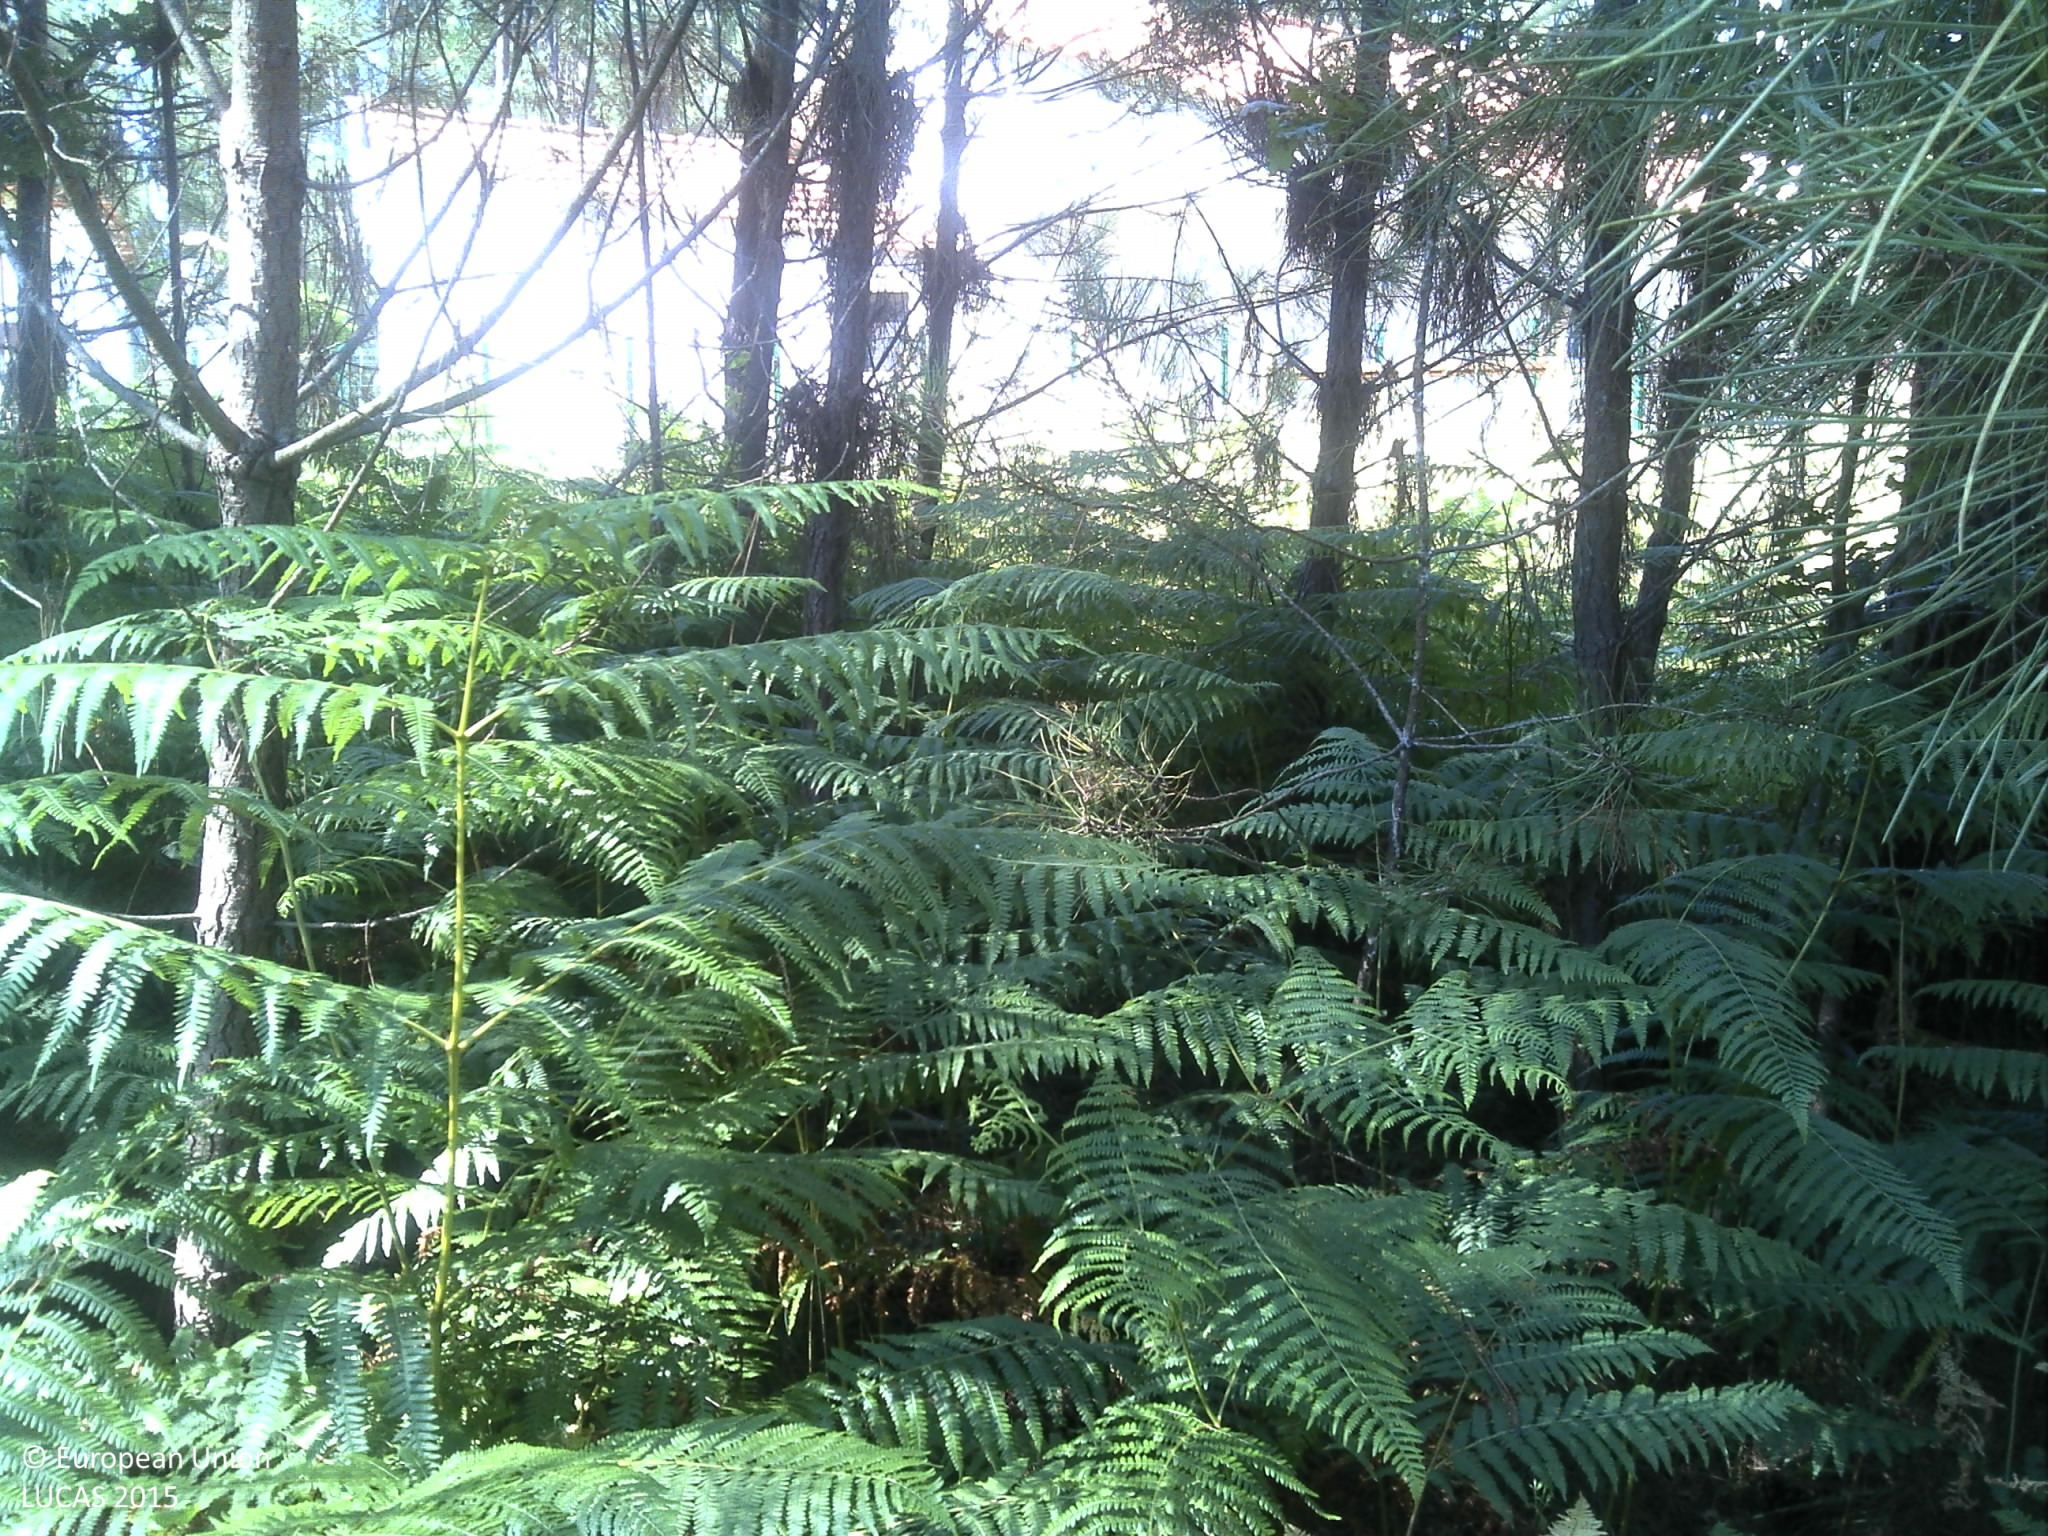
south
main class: Woodland
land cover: Pine dominated coniferous woodland
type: coniferous forest of the mediterranean region
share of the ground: 50 - 75 %
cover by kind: coniferous forest trees 65 %, shrubs 30 %, unconsolidated bare surface 5 %
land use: Forestry
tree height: > 5 m
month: June
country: PT
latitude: 41.3917
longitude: -8.1176
